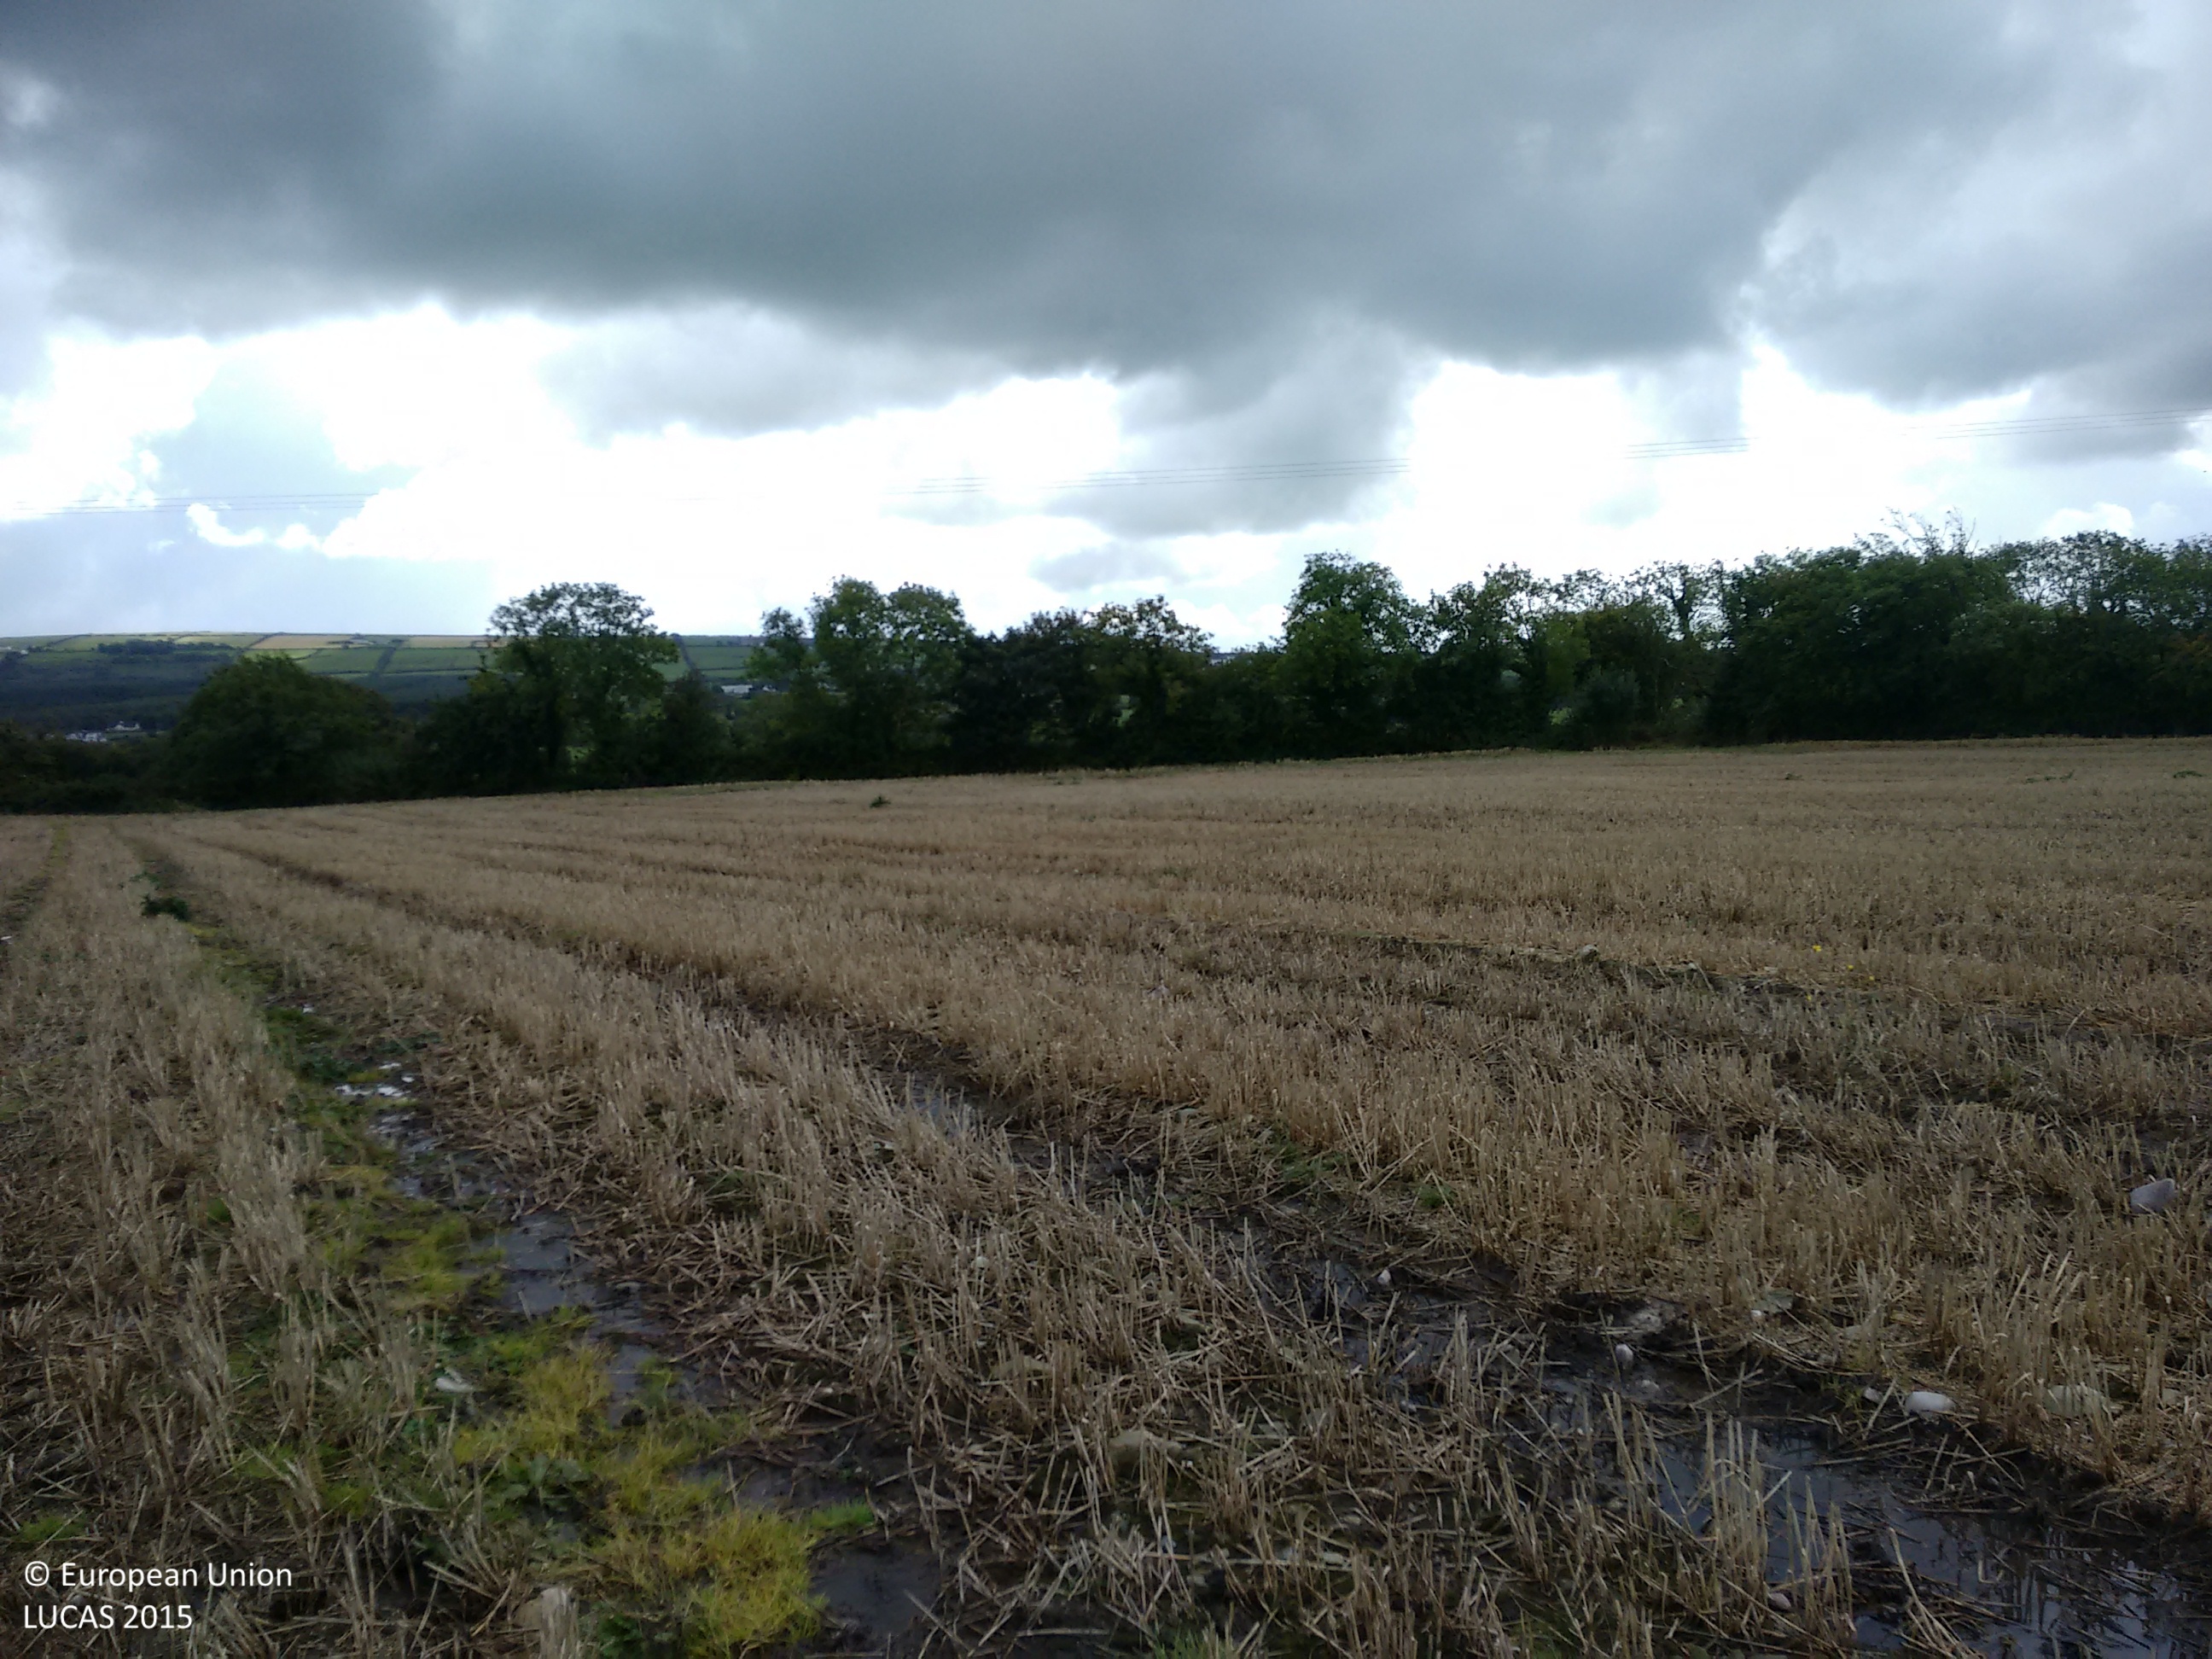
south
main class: Cropland
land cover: Common wheat
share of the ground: 25 - 50 %
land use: Agriculture (excluding fallow land and kitchen gardens)
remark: Harvested field
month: September
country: IE
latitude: 52.4306
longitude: -9.4540
